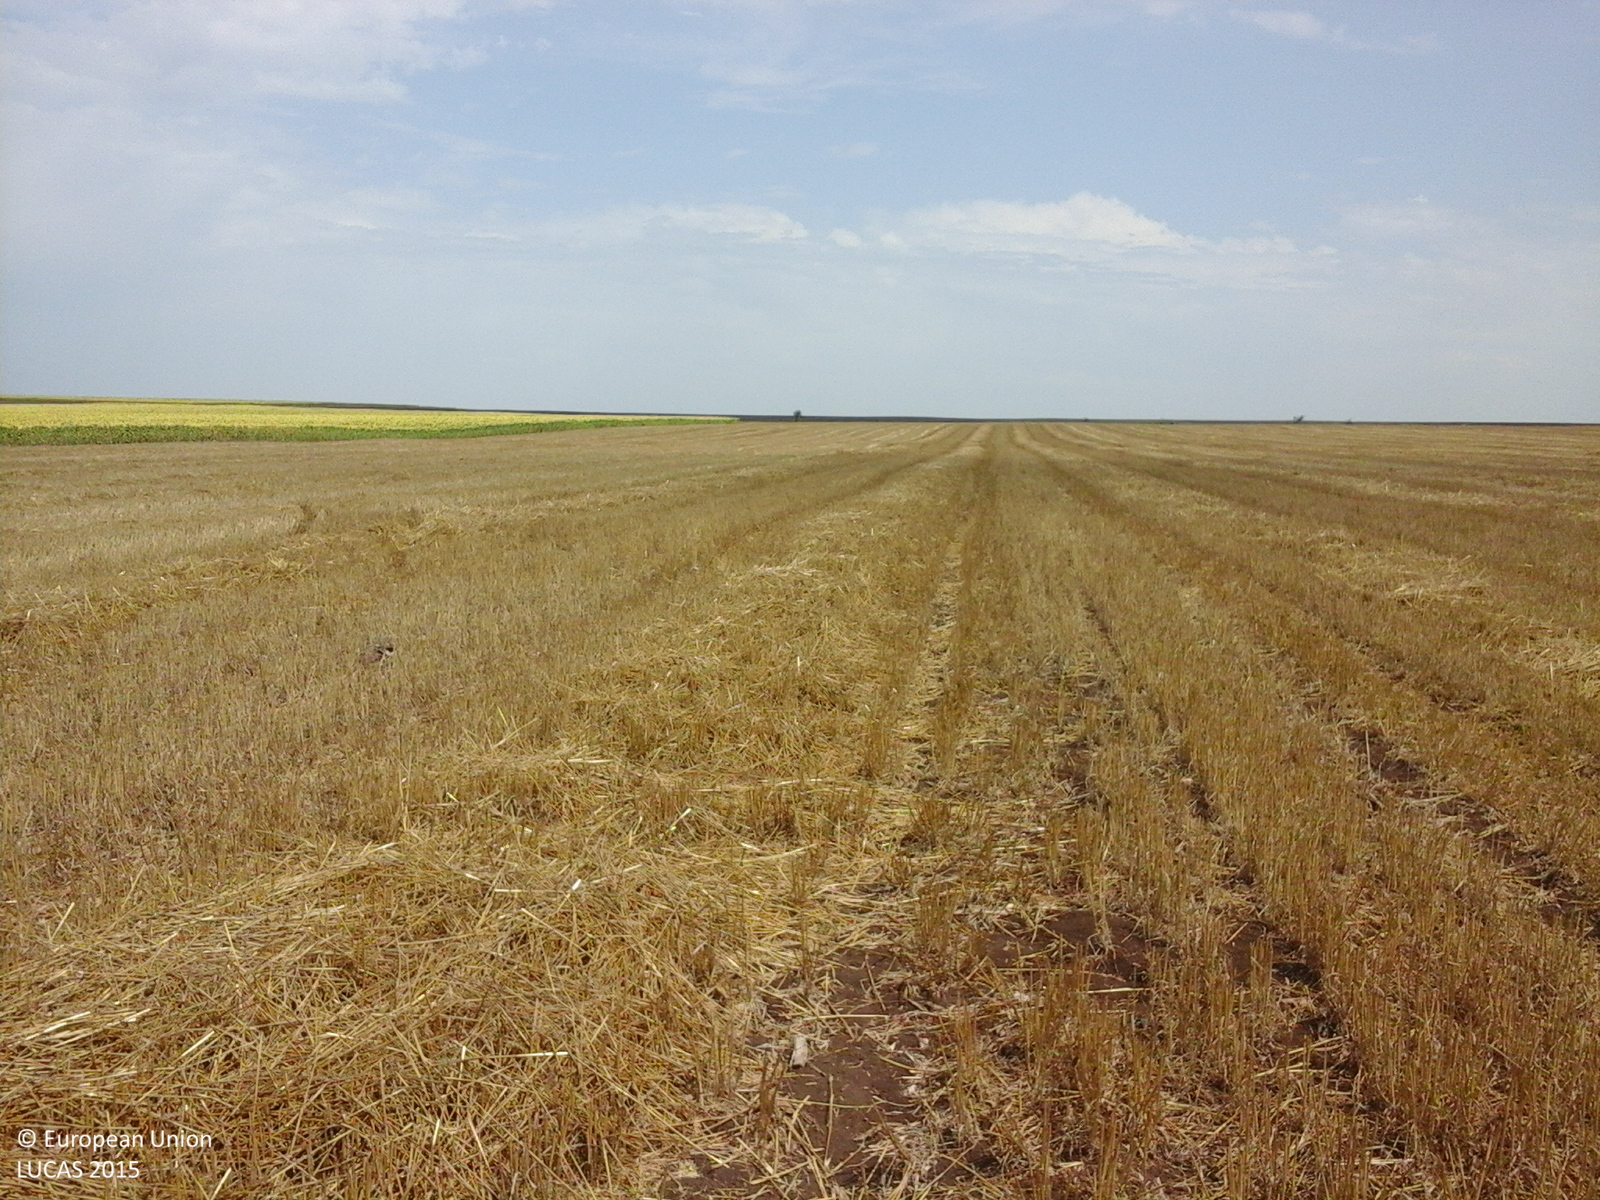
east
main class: Cropland
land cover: Common wheat
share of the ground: > 75 %
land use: Agriculture (excluding fallow land and kitchen gardens)
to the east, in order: Common wheat
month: August
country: RO
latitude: 43.7836
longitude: 28.2616
